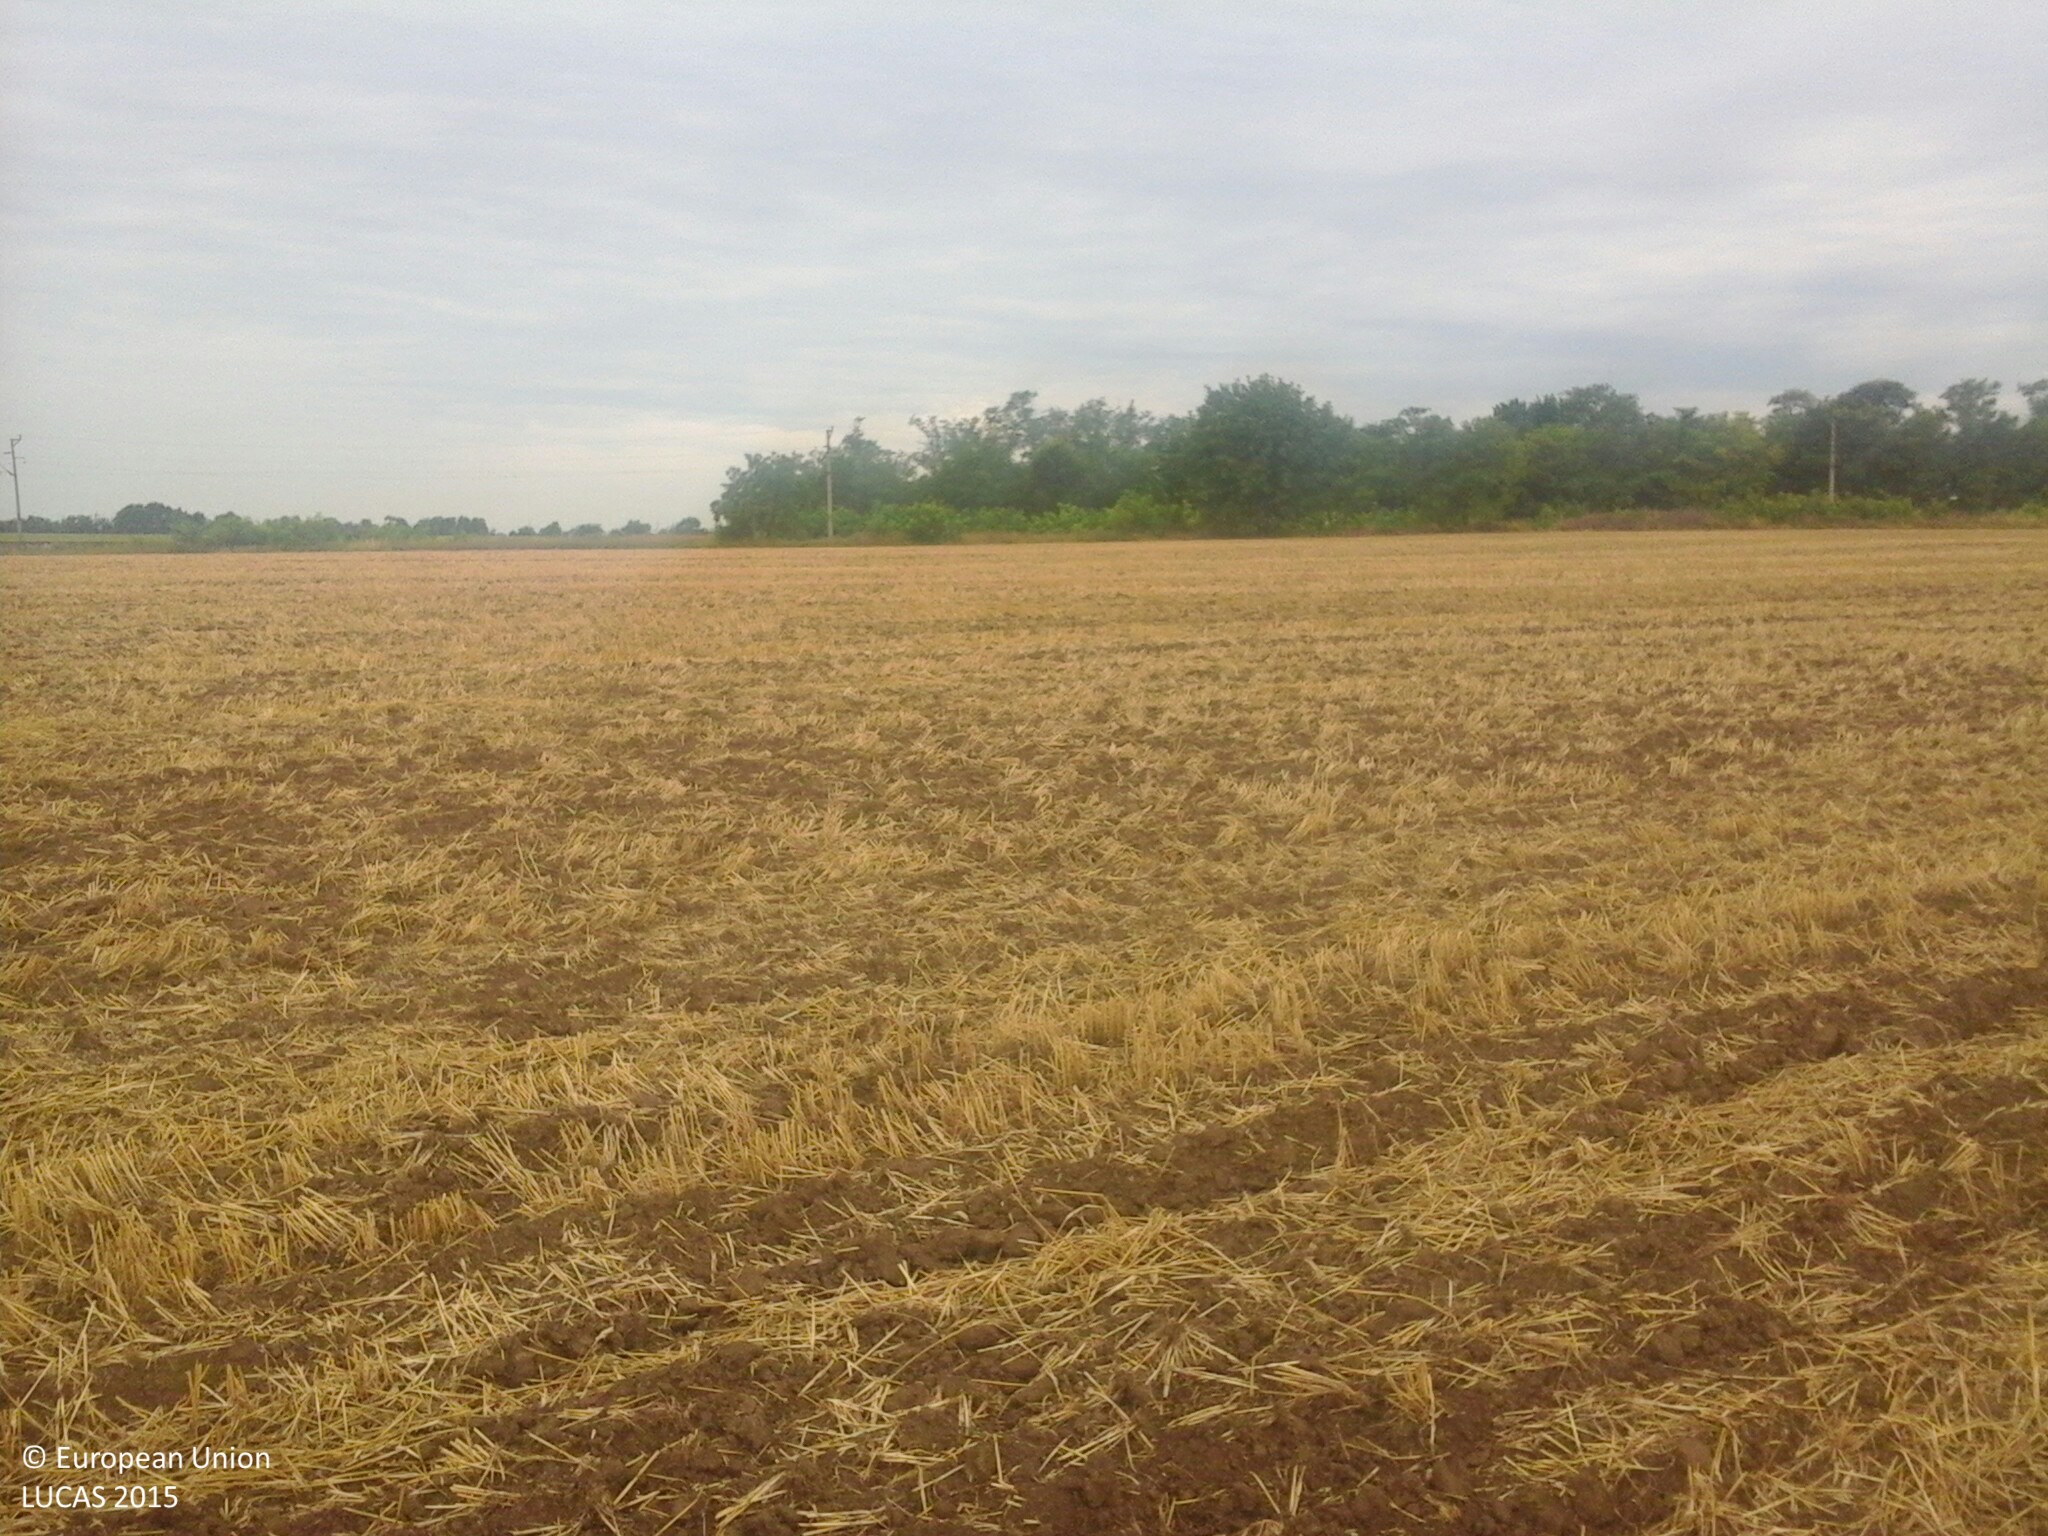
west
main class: Cropland
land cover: Oats
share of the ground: < 10 %
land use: Agriculture (excluding fallow land and kitchen gardens)
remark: Harvested field
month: July
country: HU
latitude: 47.0723
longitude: 18.3738
